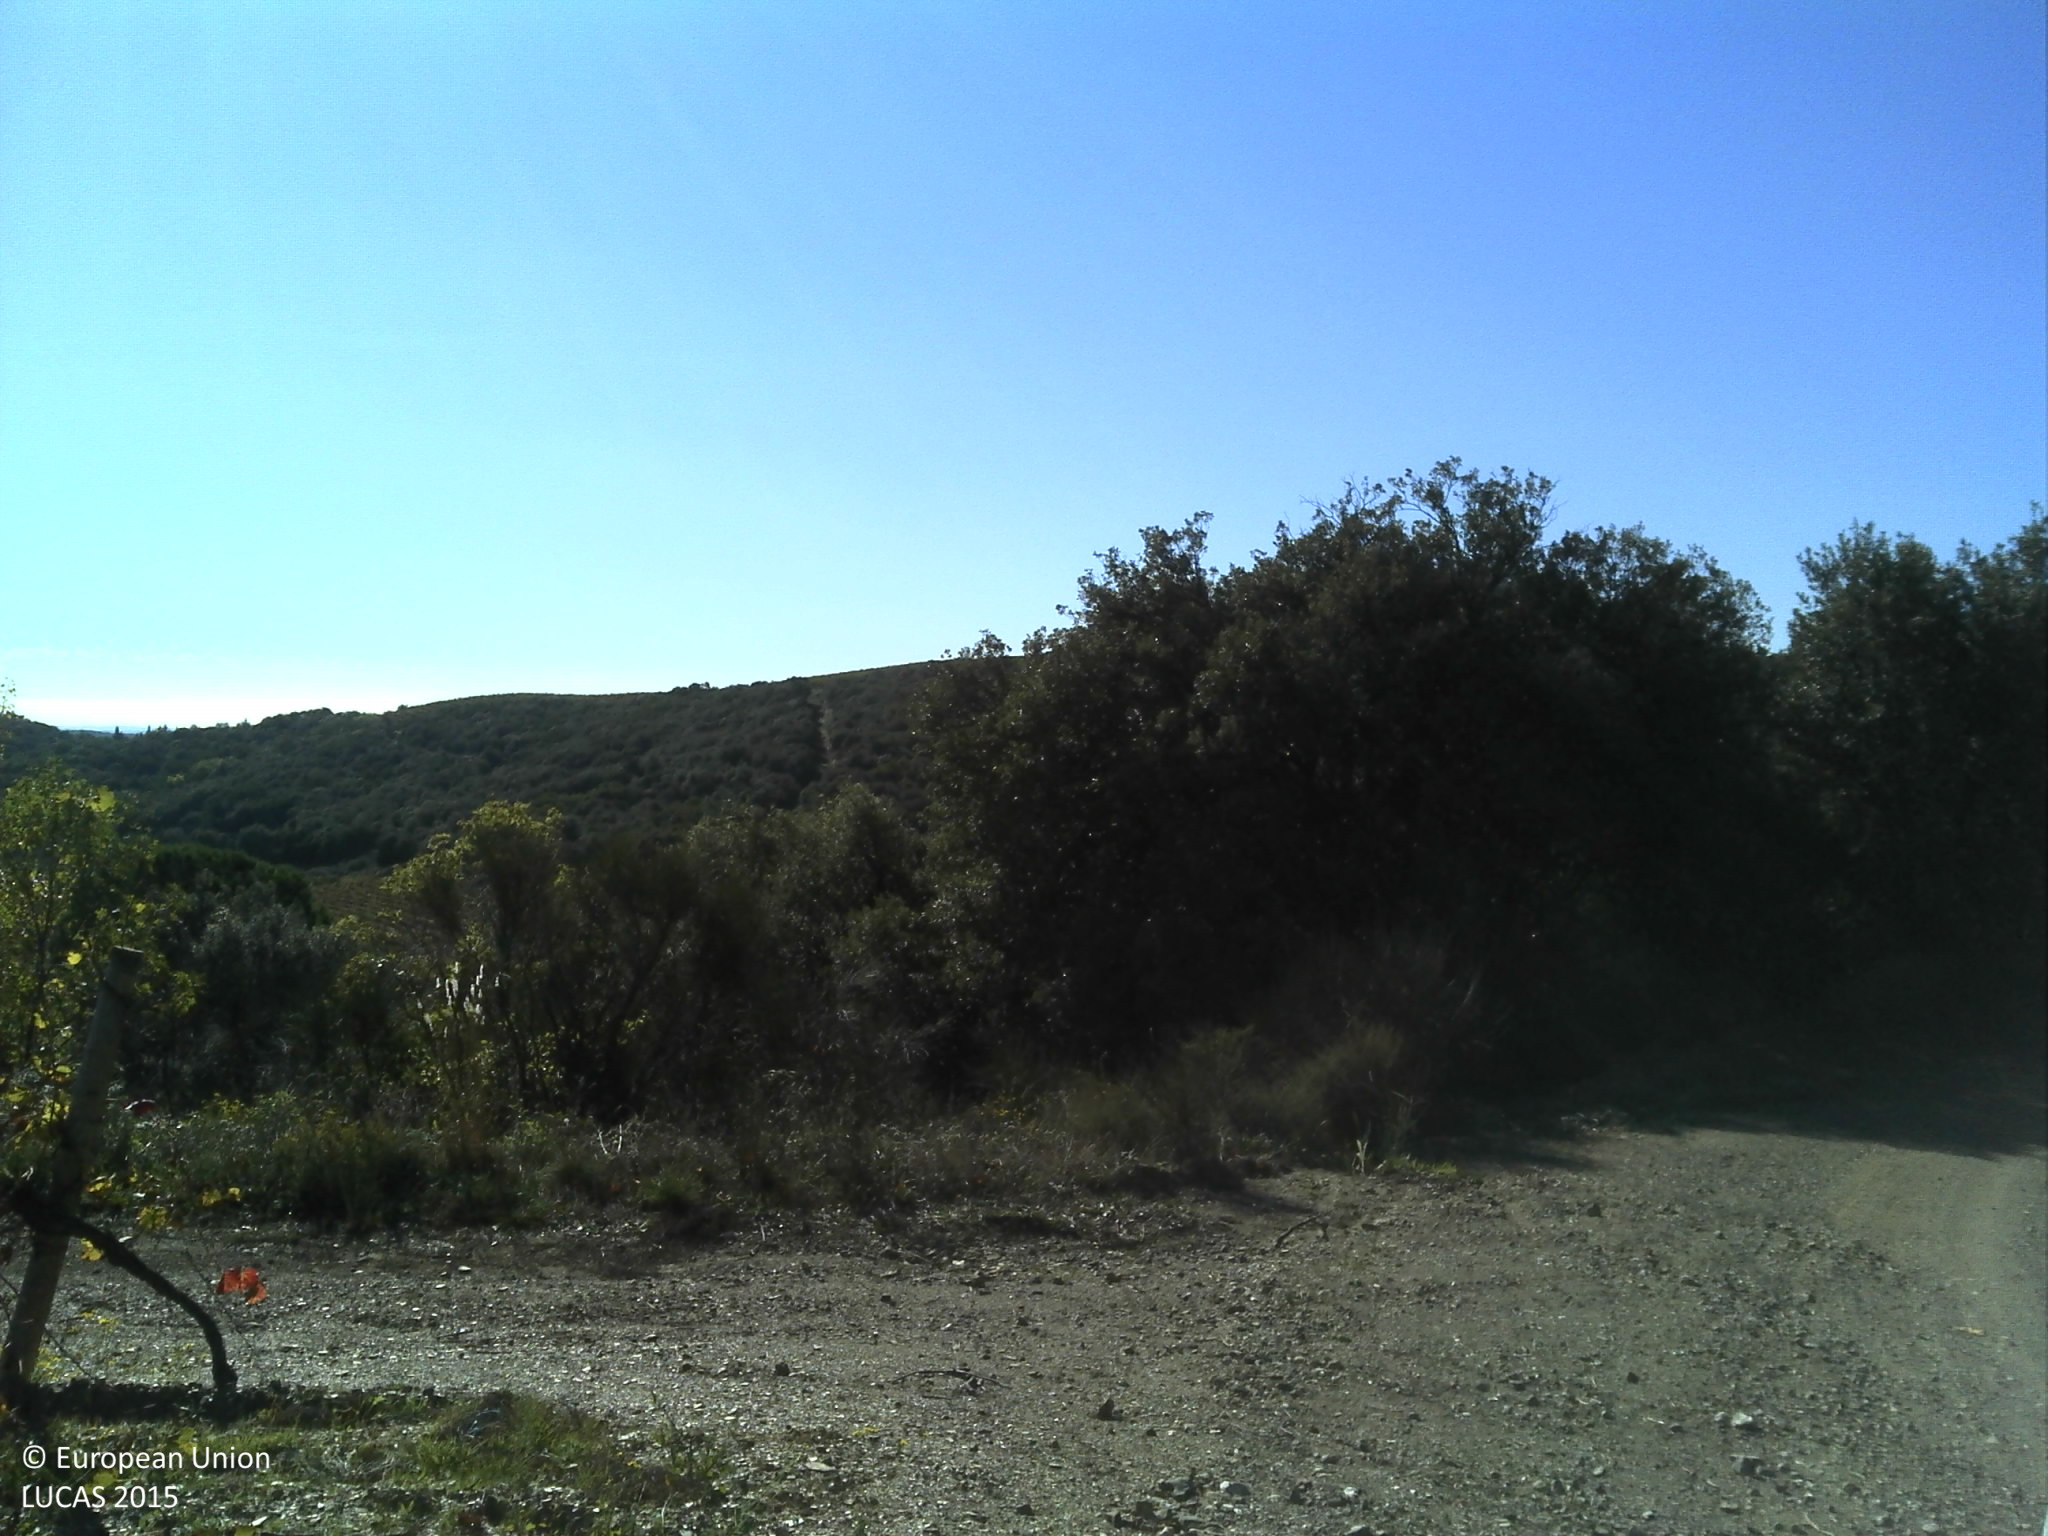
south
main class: Cropland
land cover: Vineyards
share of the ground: 10 - 25 %
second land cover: Spontaneously vegetated surfaces
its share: > 75 %
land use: Agriculture (excluding fallow land and kitchen gardens)
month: October
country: FR
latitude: 43.5246
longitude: 3.1169
